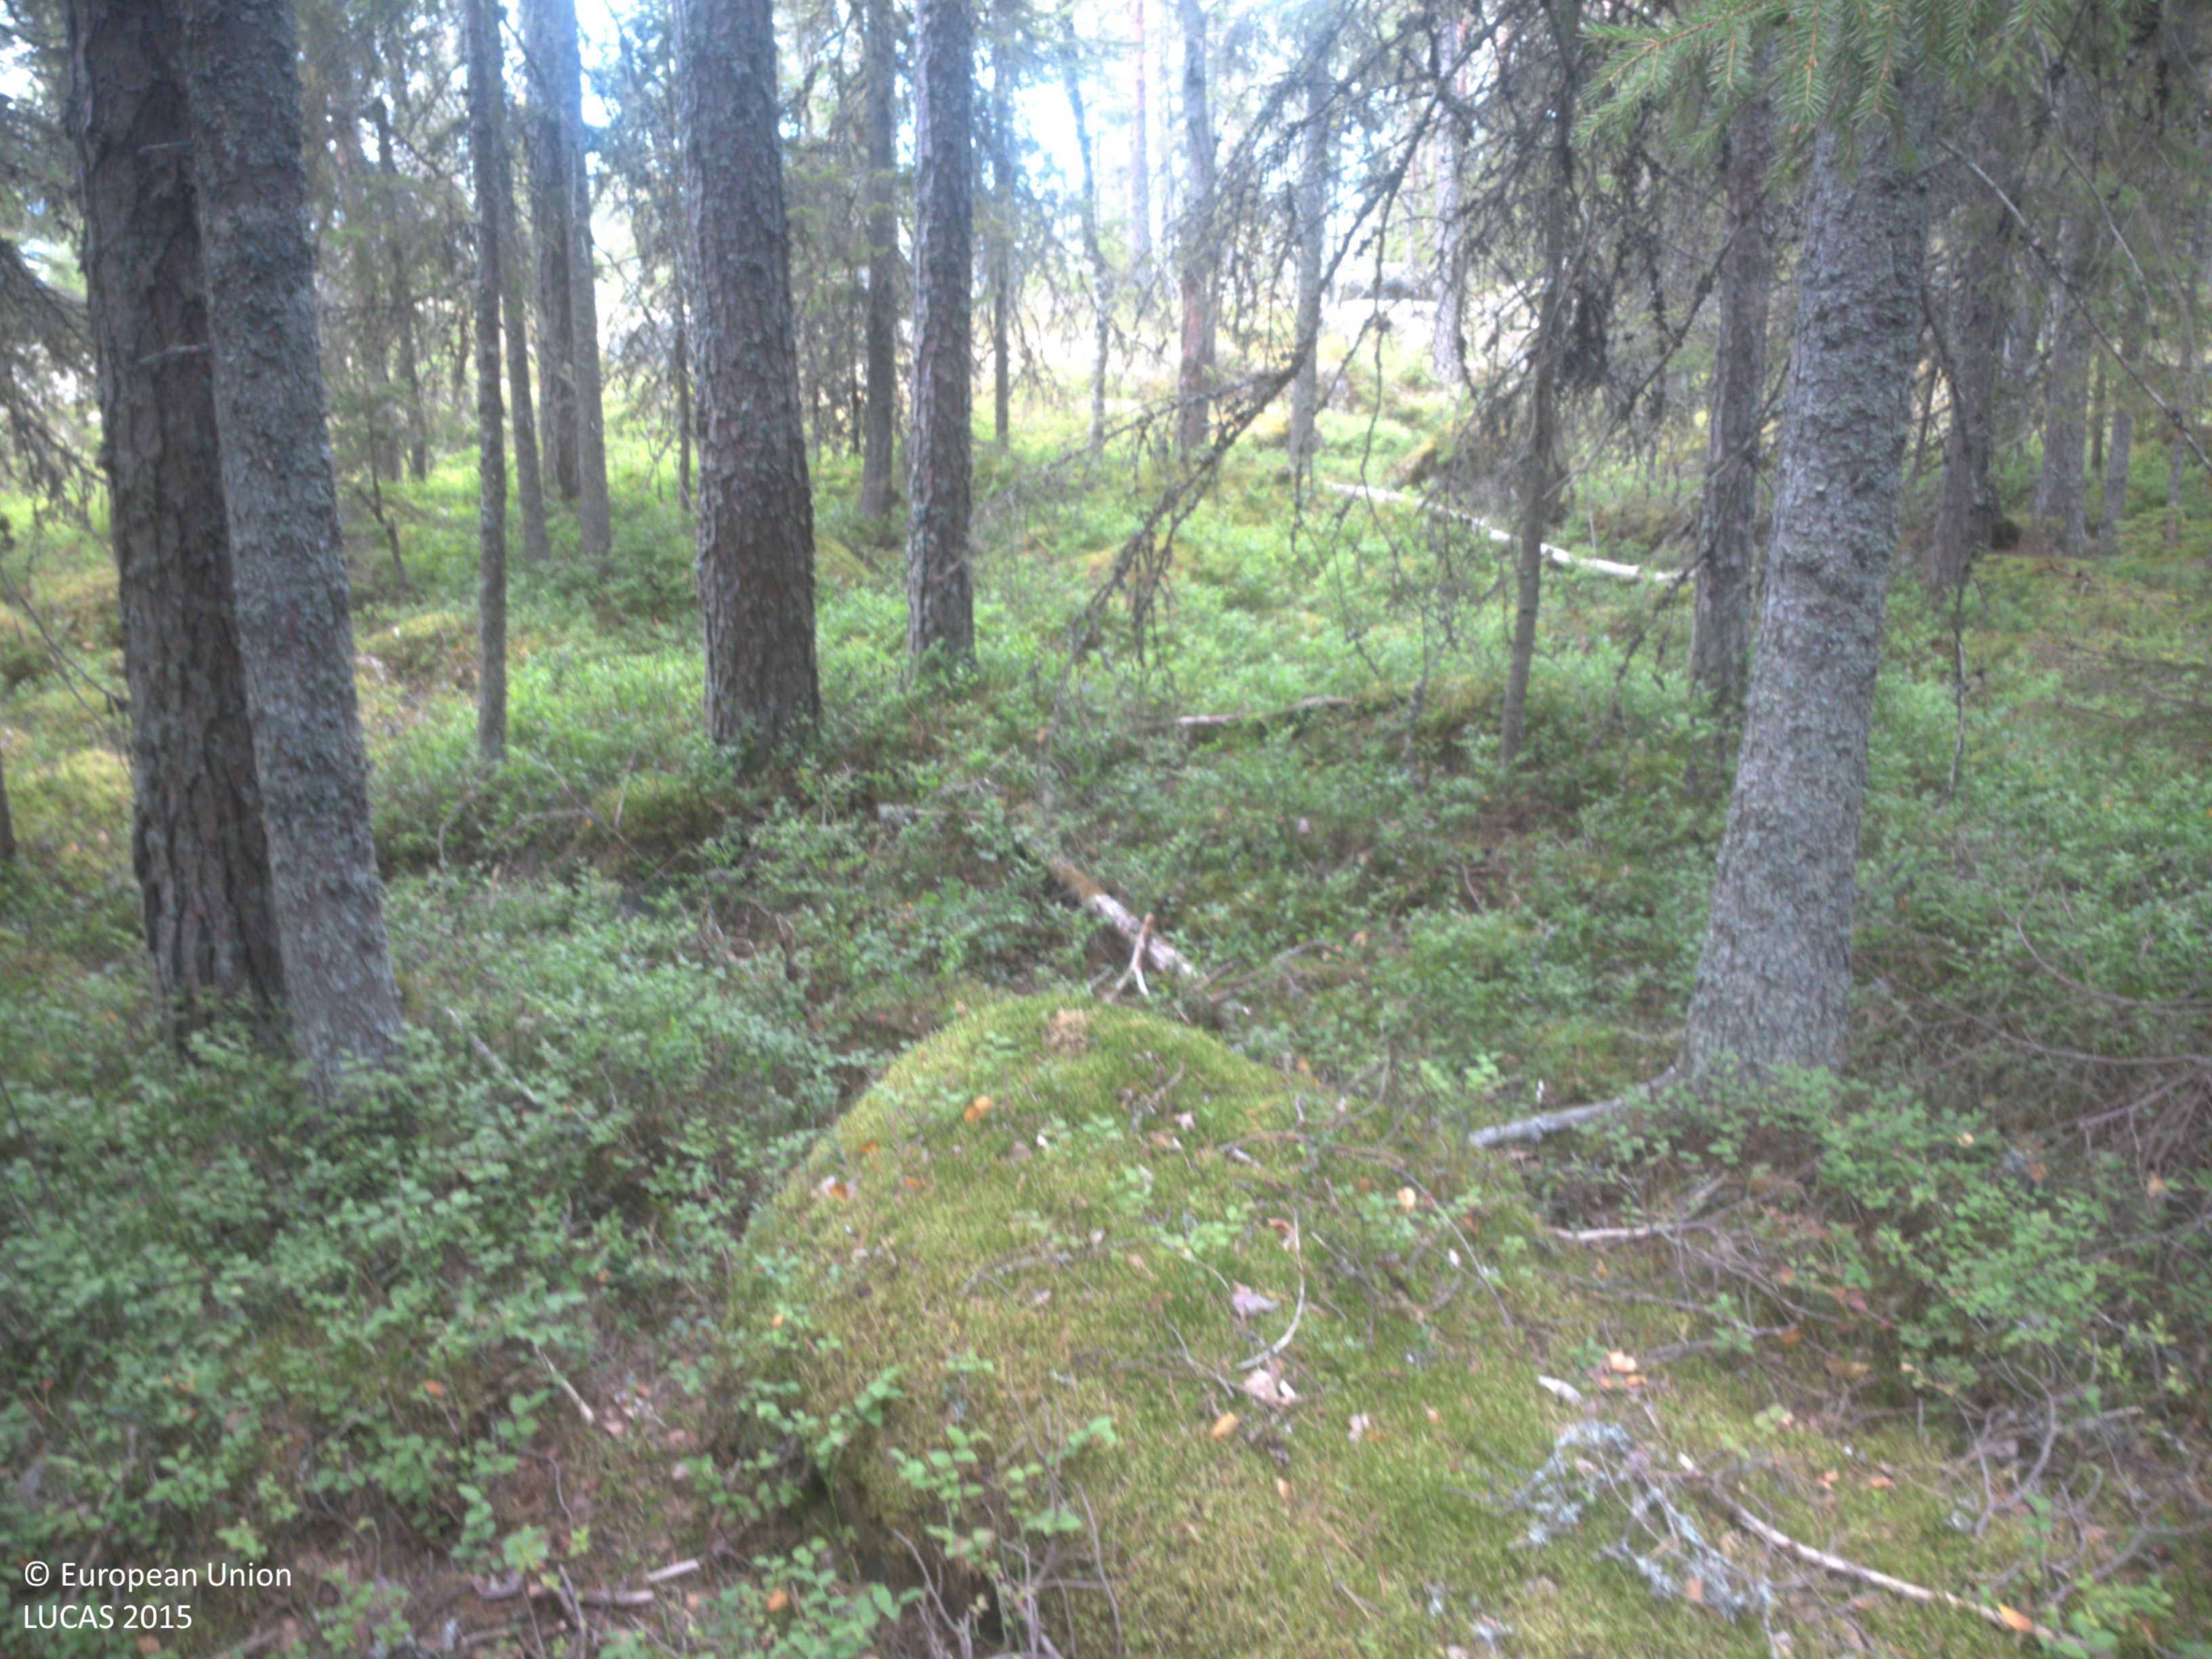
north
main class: Woodland
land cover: Other coniferous woodland
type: boreal forest
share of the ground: 50 - 75 %
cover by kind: coniferous forest trees 50 %, shrubs 50 %
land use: Forestry
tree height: > 5 m
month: August
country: SE
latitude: 63.6428
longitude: 19.4471
